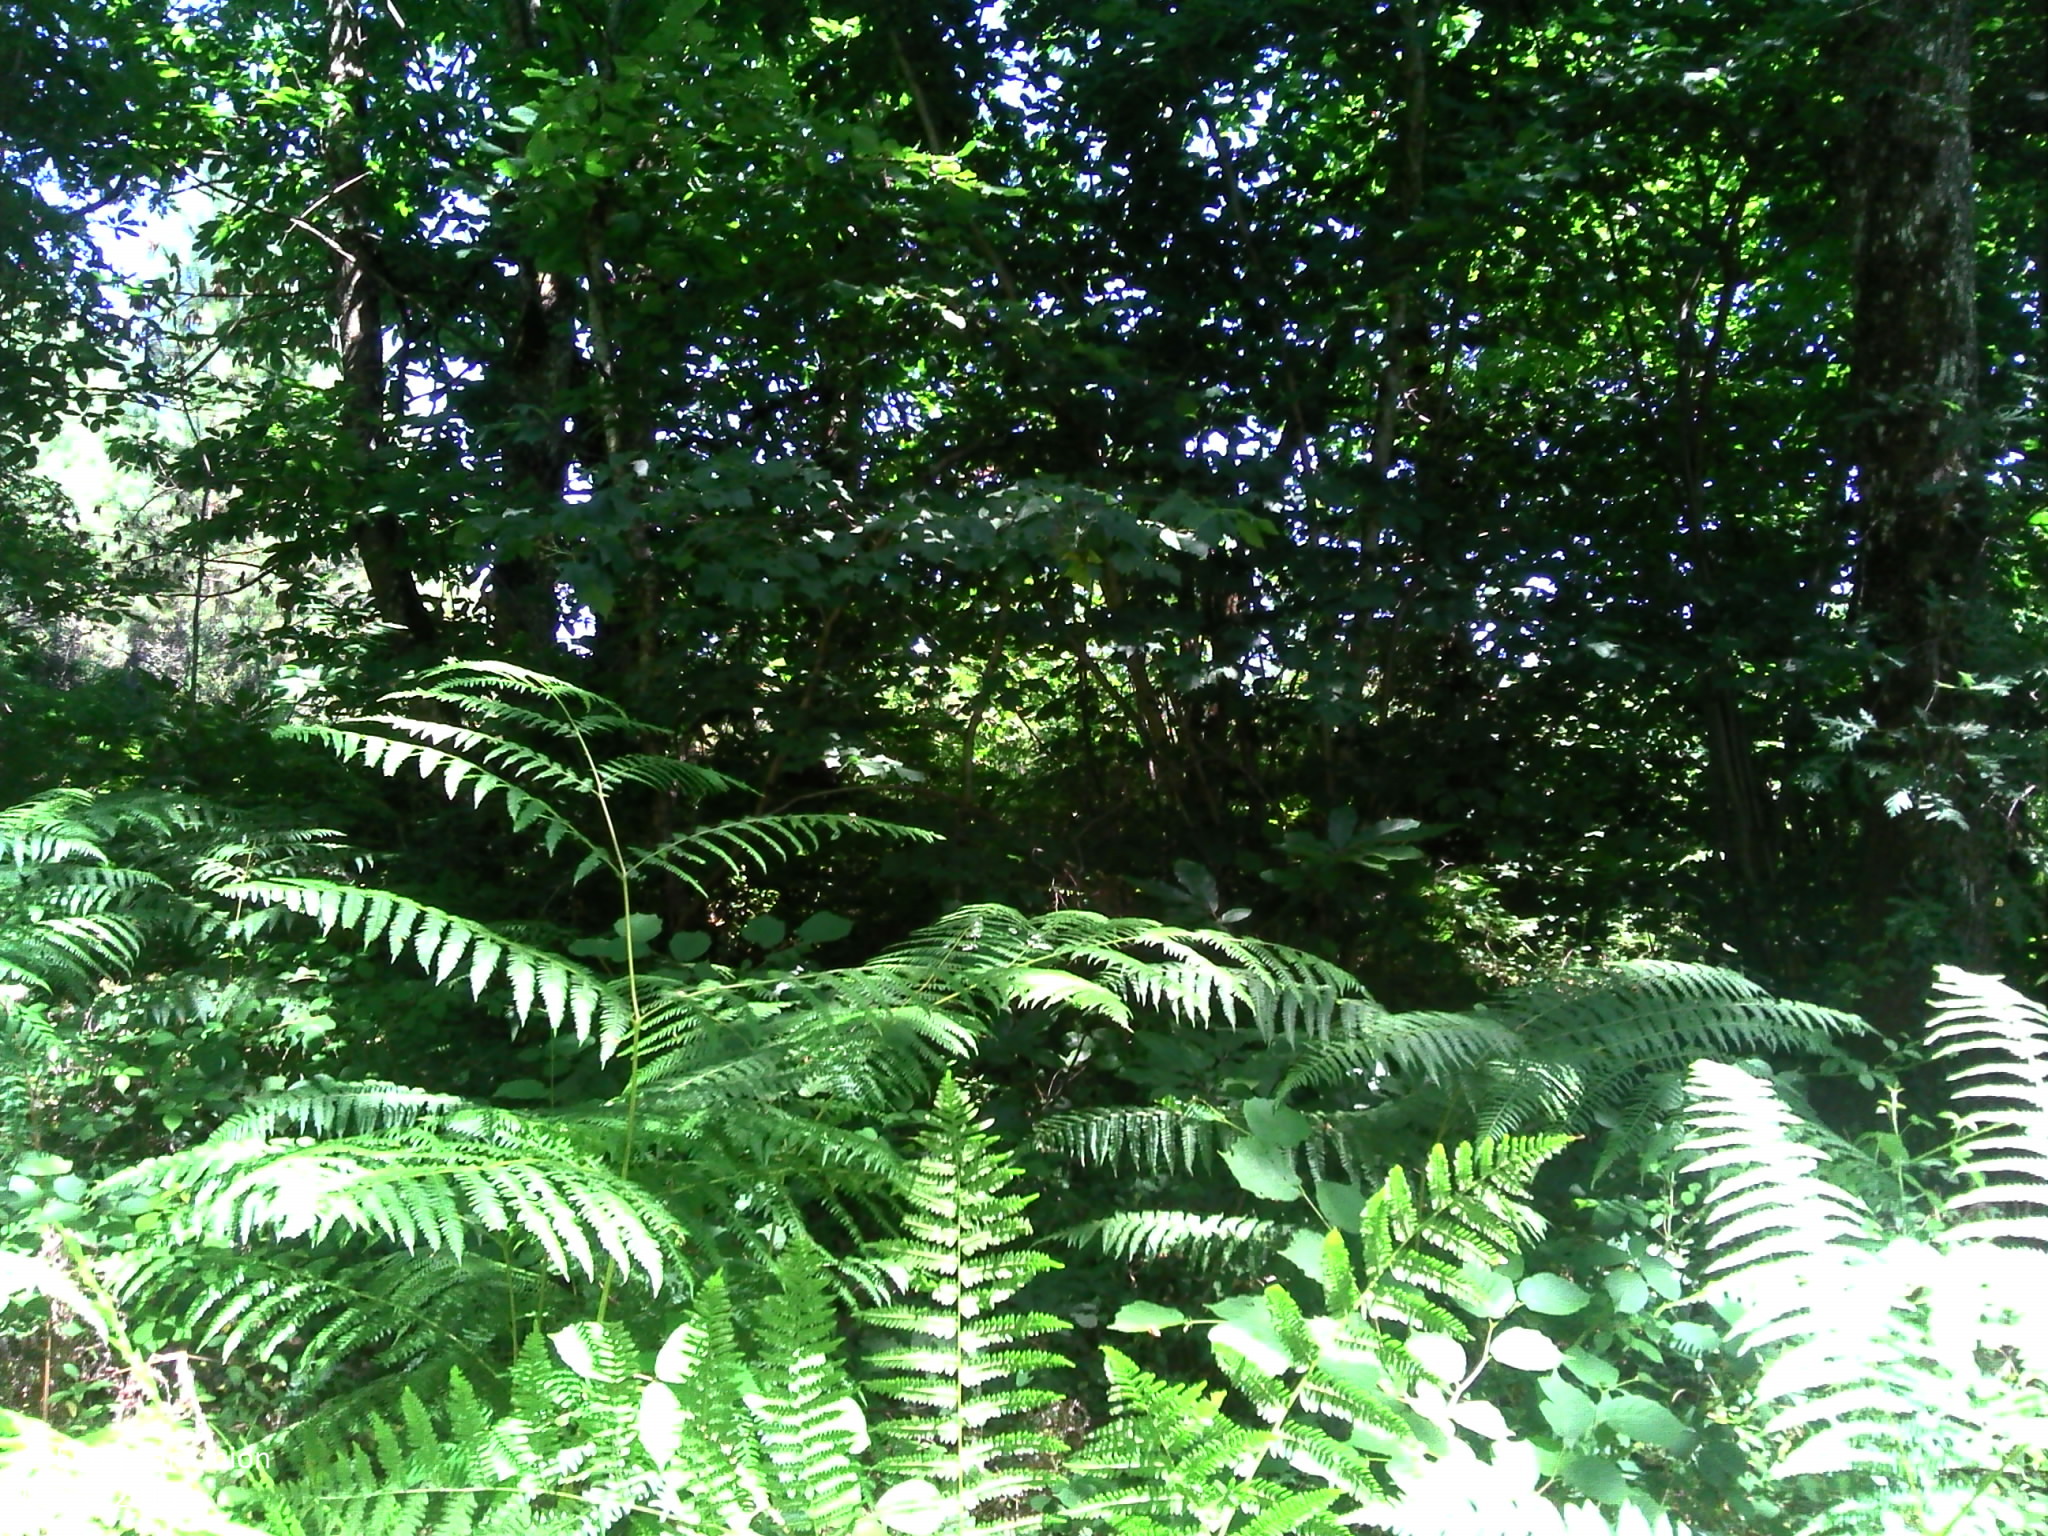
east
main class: Woodland
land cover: Broadleaved woodland
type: thermophilous deciduous forest
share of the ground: > 75 %
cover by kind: broadleaved forest trees 85 %, herbaceous plants 15 %
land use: Forestry
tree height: > 5 m
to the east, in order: Broadleaved woodland; Pine dominated coniferous woodland; Spontaneously vegetated surfaces; Pine dominated coniferous woodland; Broadleaved woodland
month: June
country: FR
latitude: 44.5637
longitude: 0.8660
